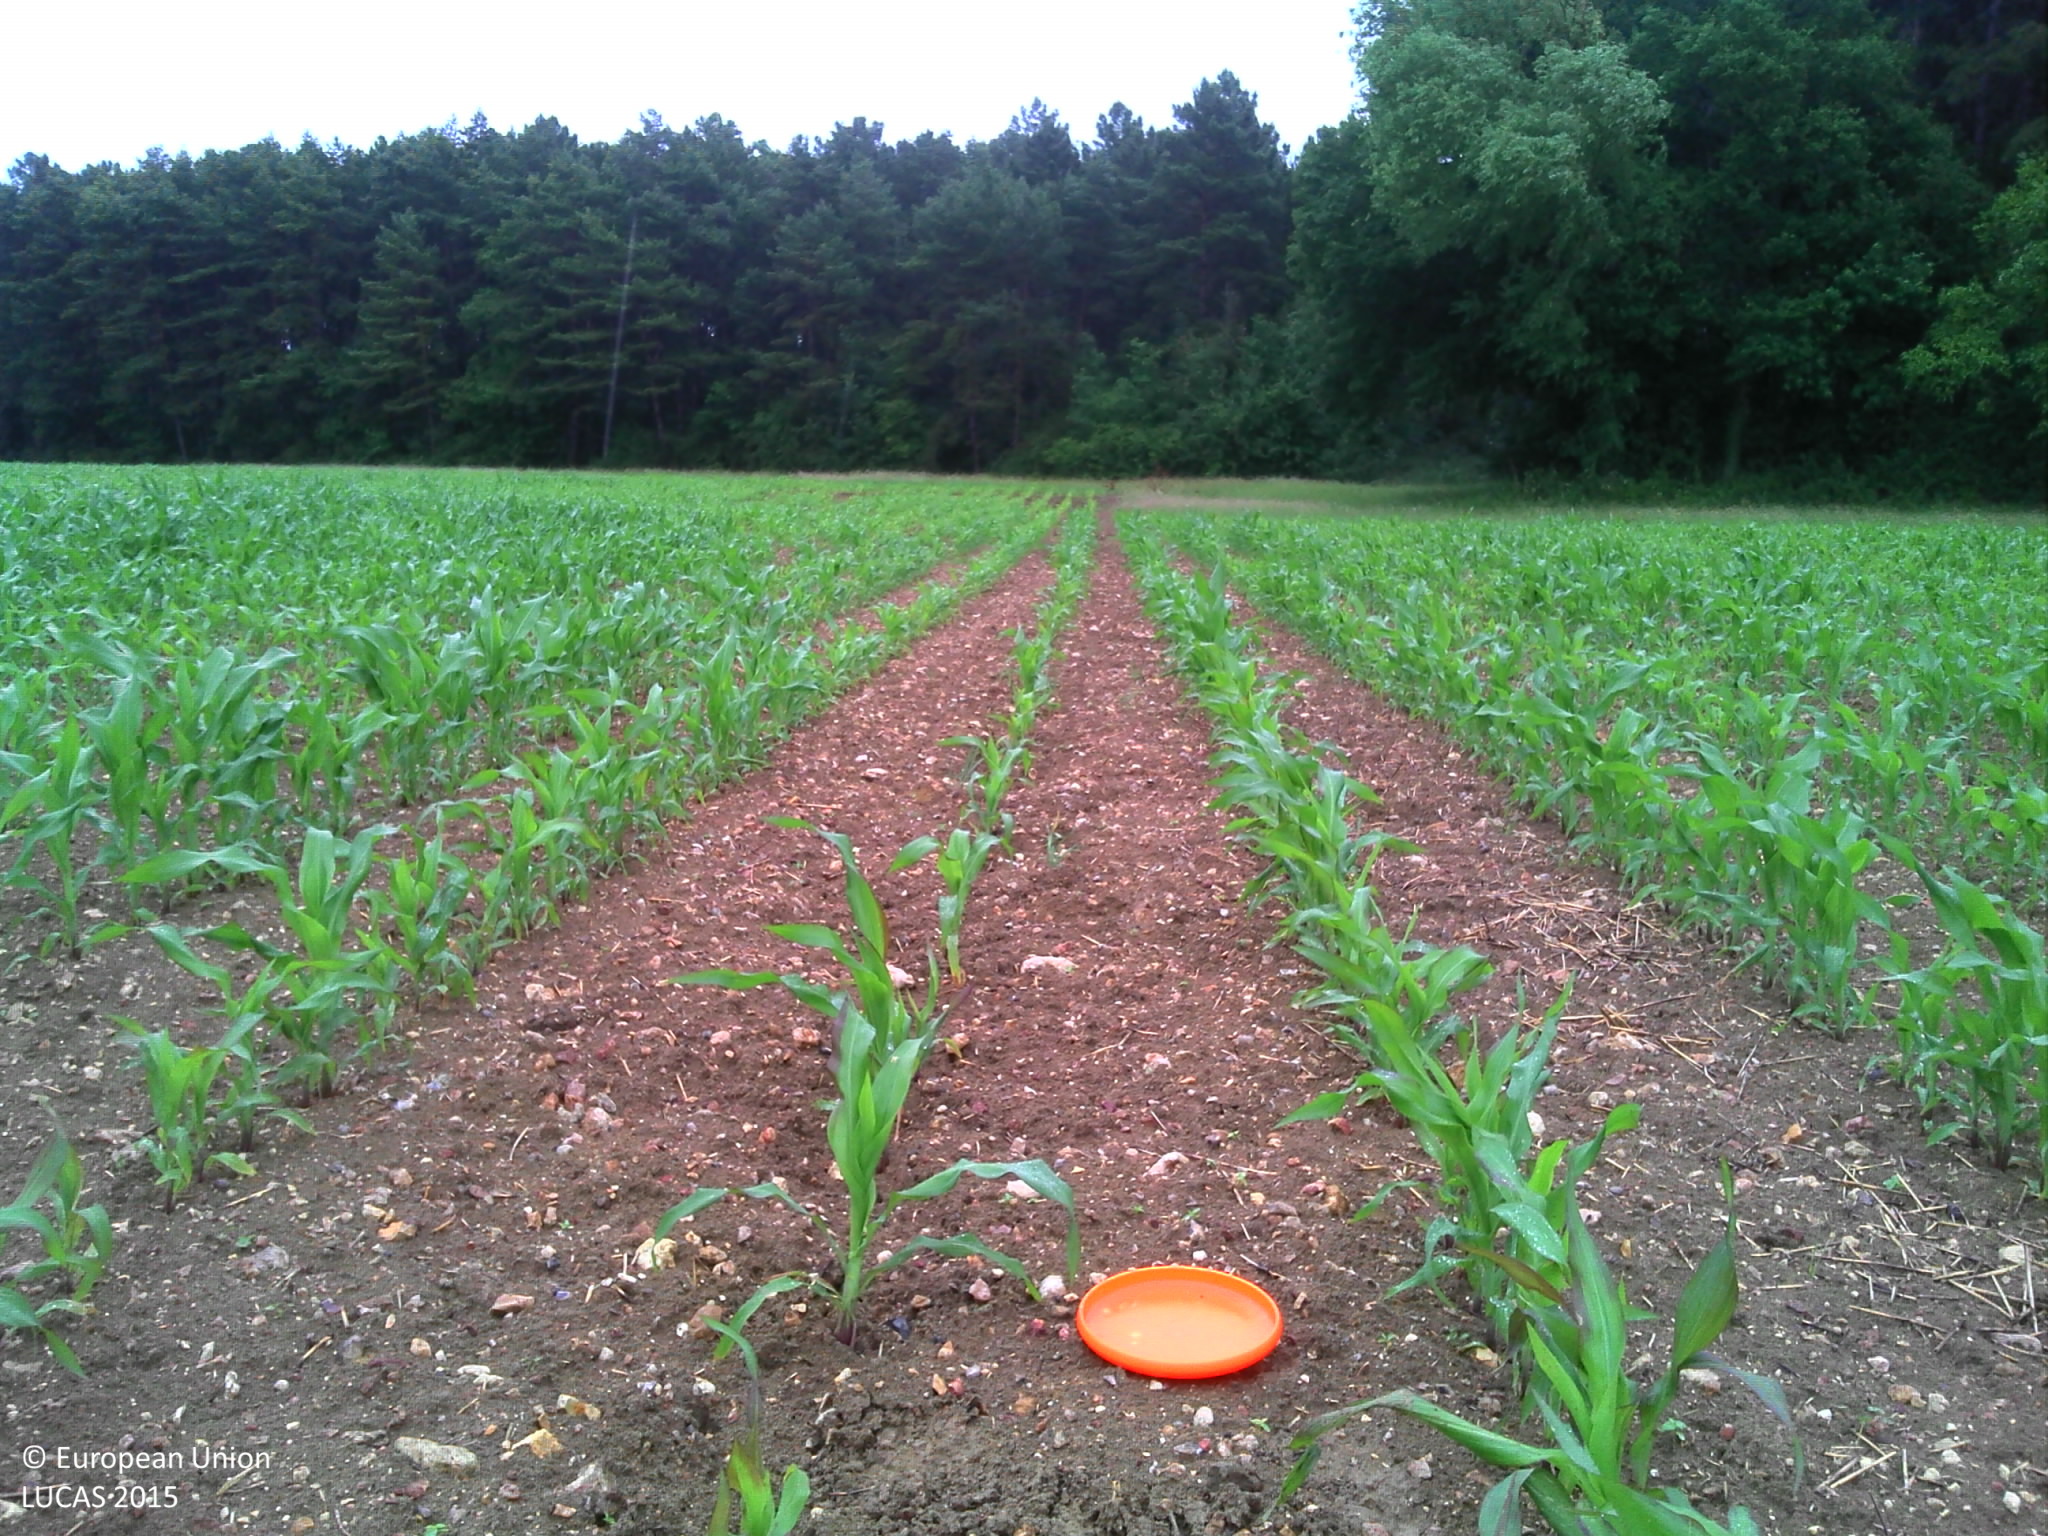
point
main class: Cropland
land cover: Maize
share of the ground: 10 - 25 %
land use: Agriculture (excluding fallow land and kitchen gardens)
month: June
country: FR
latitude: 47.6084
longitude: 0.6544
